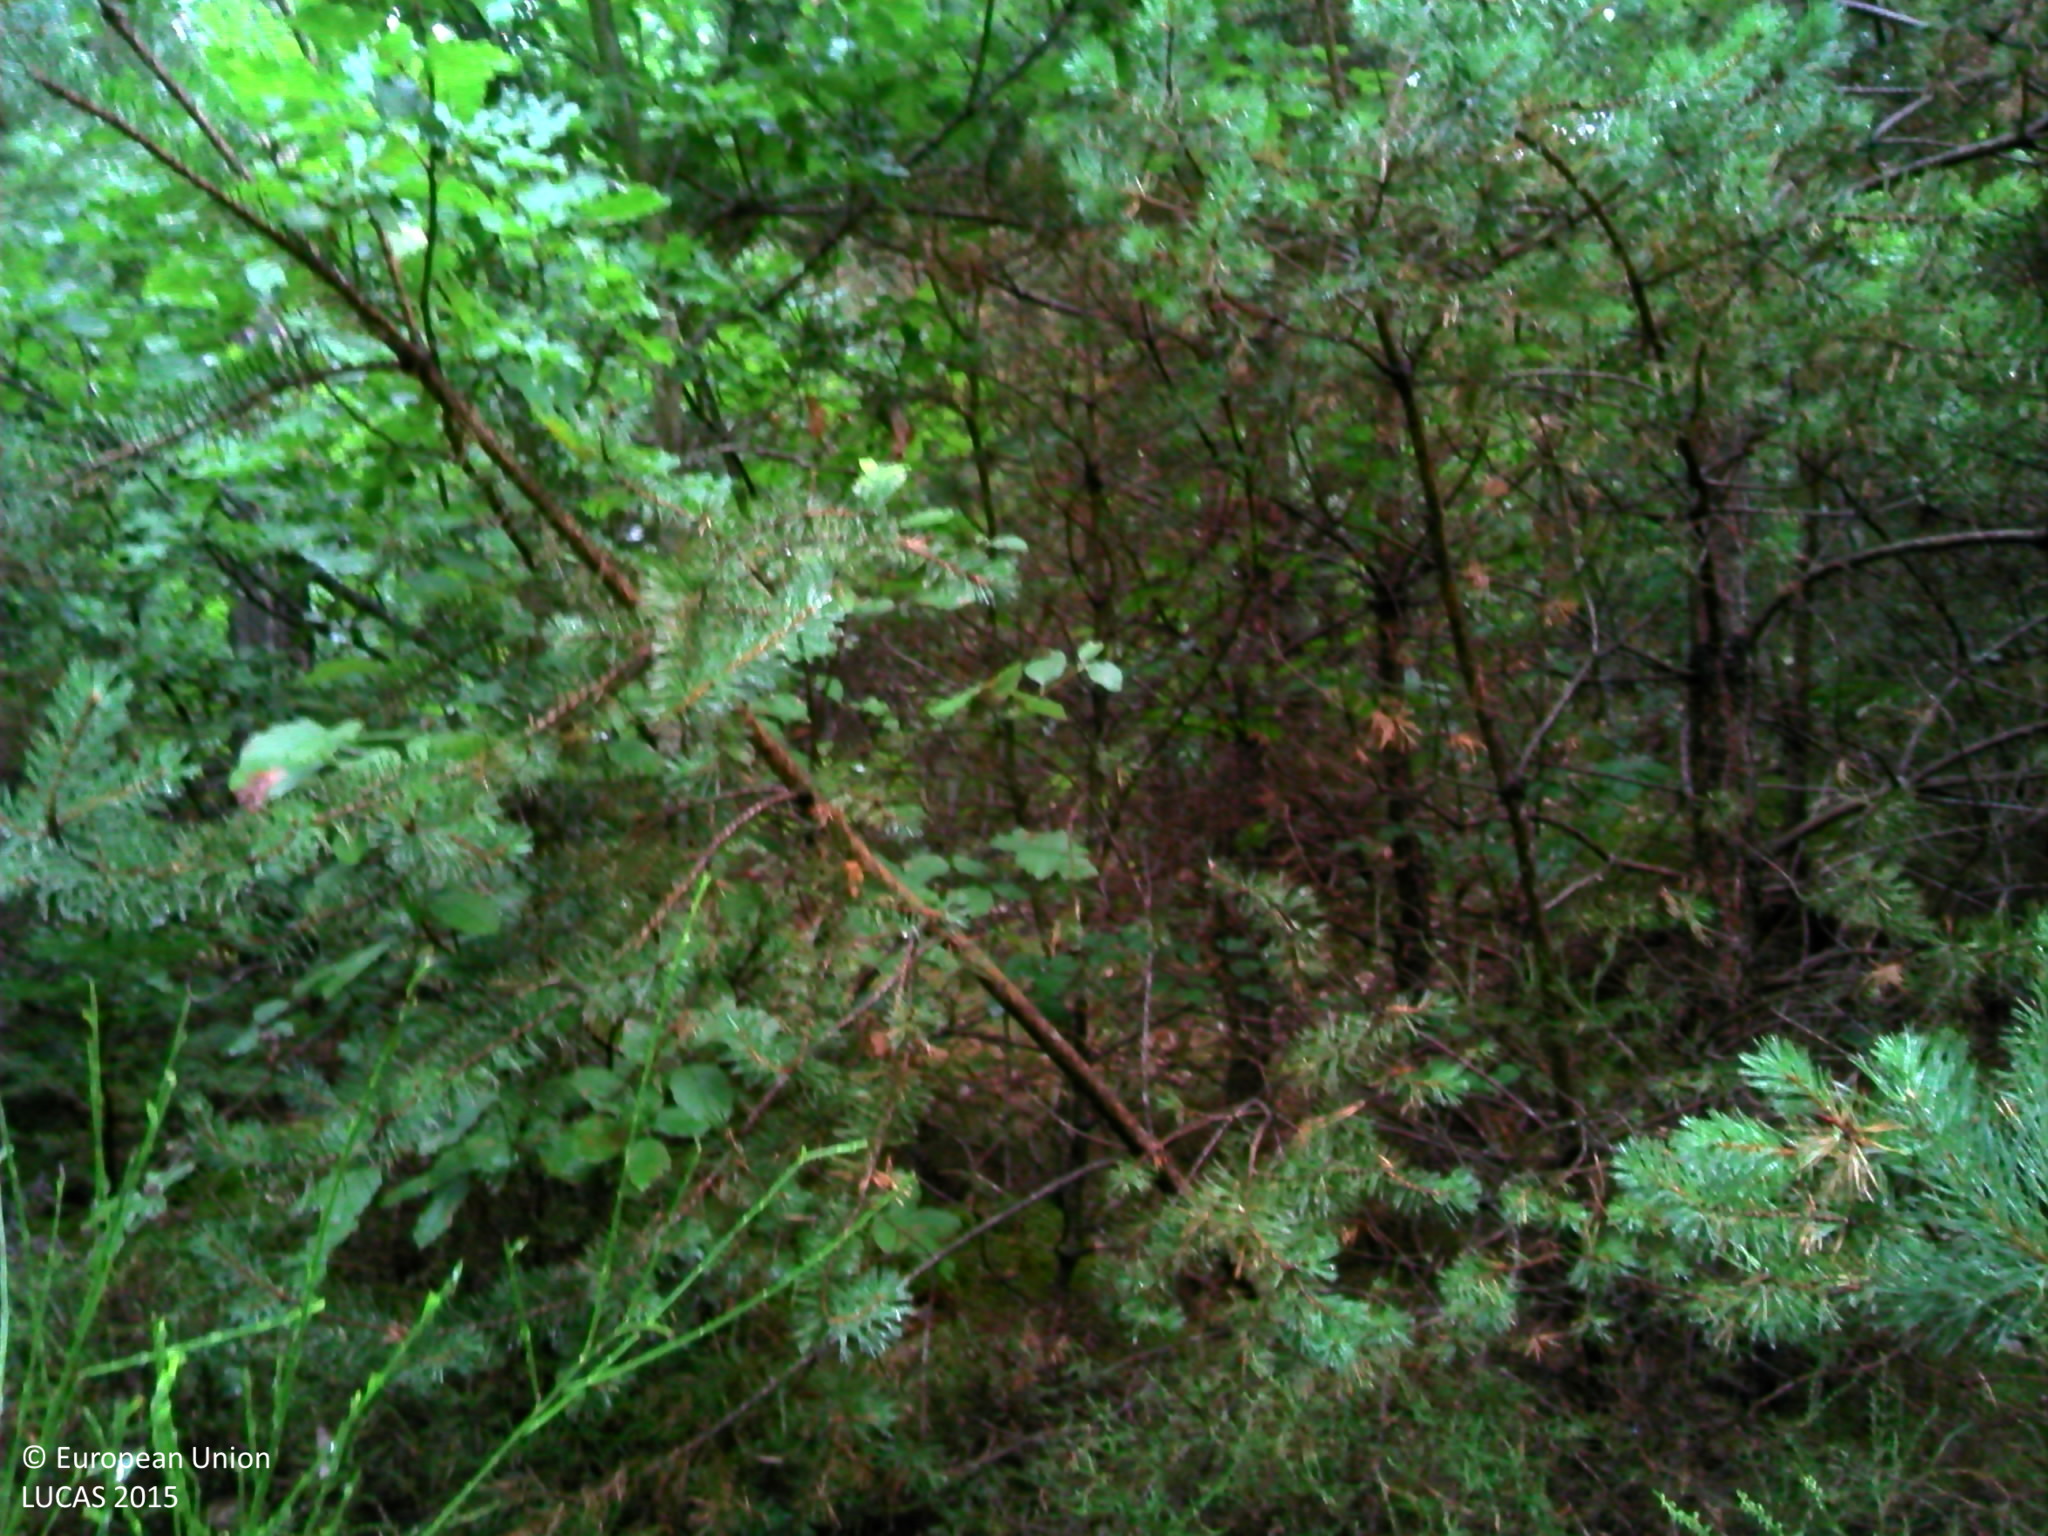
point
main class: Woodland
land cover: Broadleaved woodland
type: thermophilous deciduous forest
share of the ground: > 75 %
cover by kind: broadleaved forest trees 65 %, coniferous forest trees 10 %, shrubs 10 %, lichens and mosses 10 %, herbaceous plants 5 %
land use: Forestry
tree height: > 5 m
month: July
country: FR
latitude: 45.4691
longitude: 4.1580
